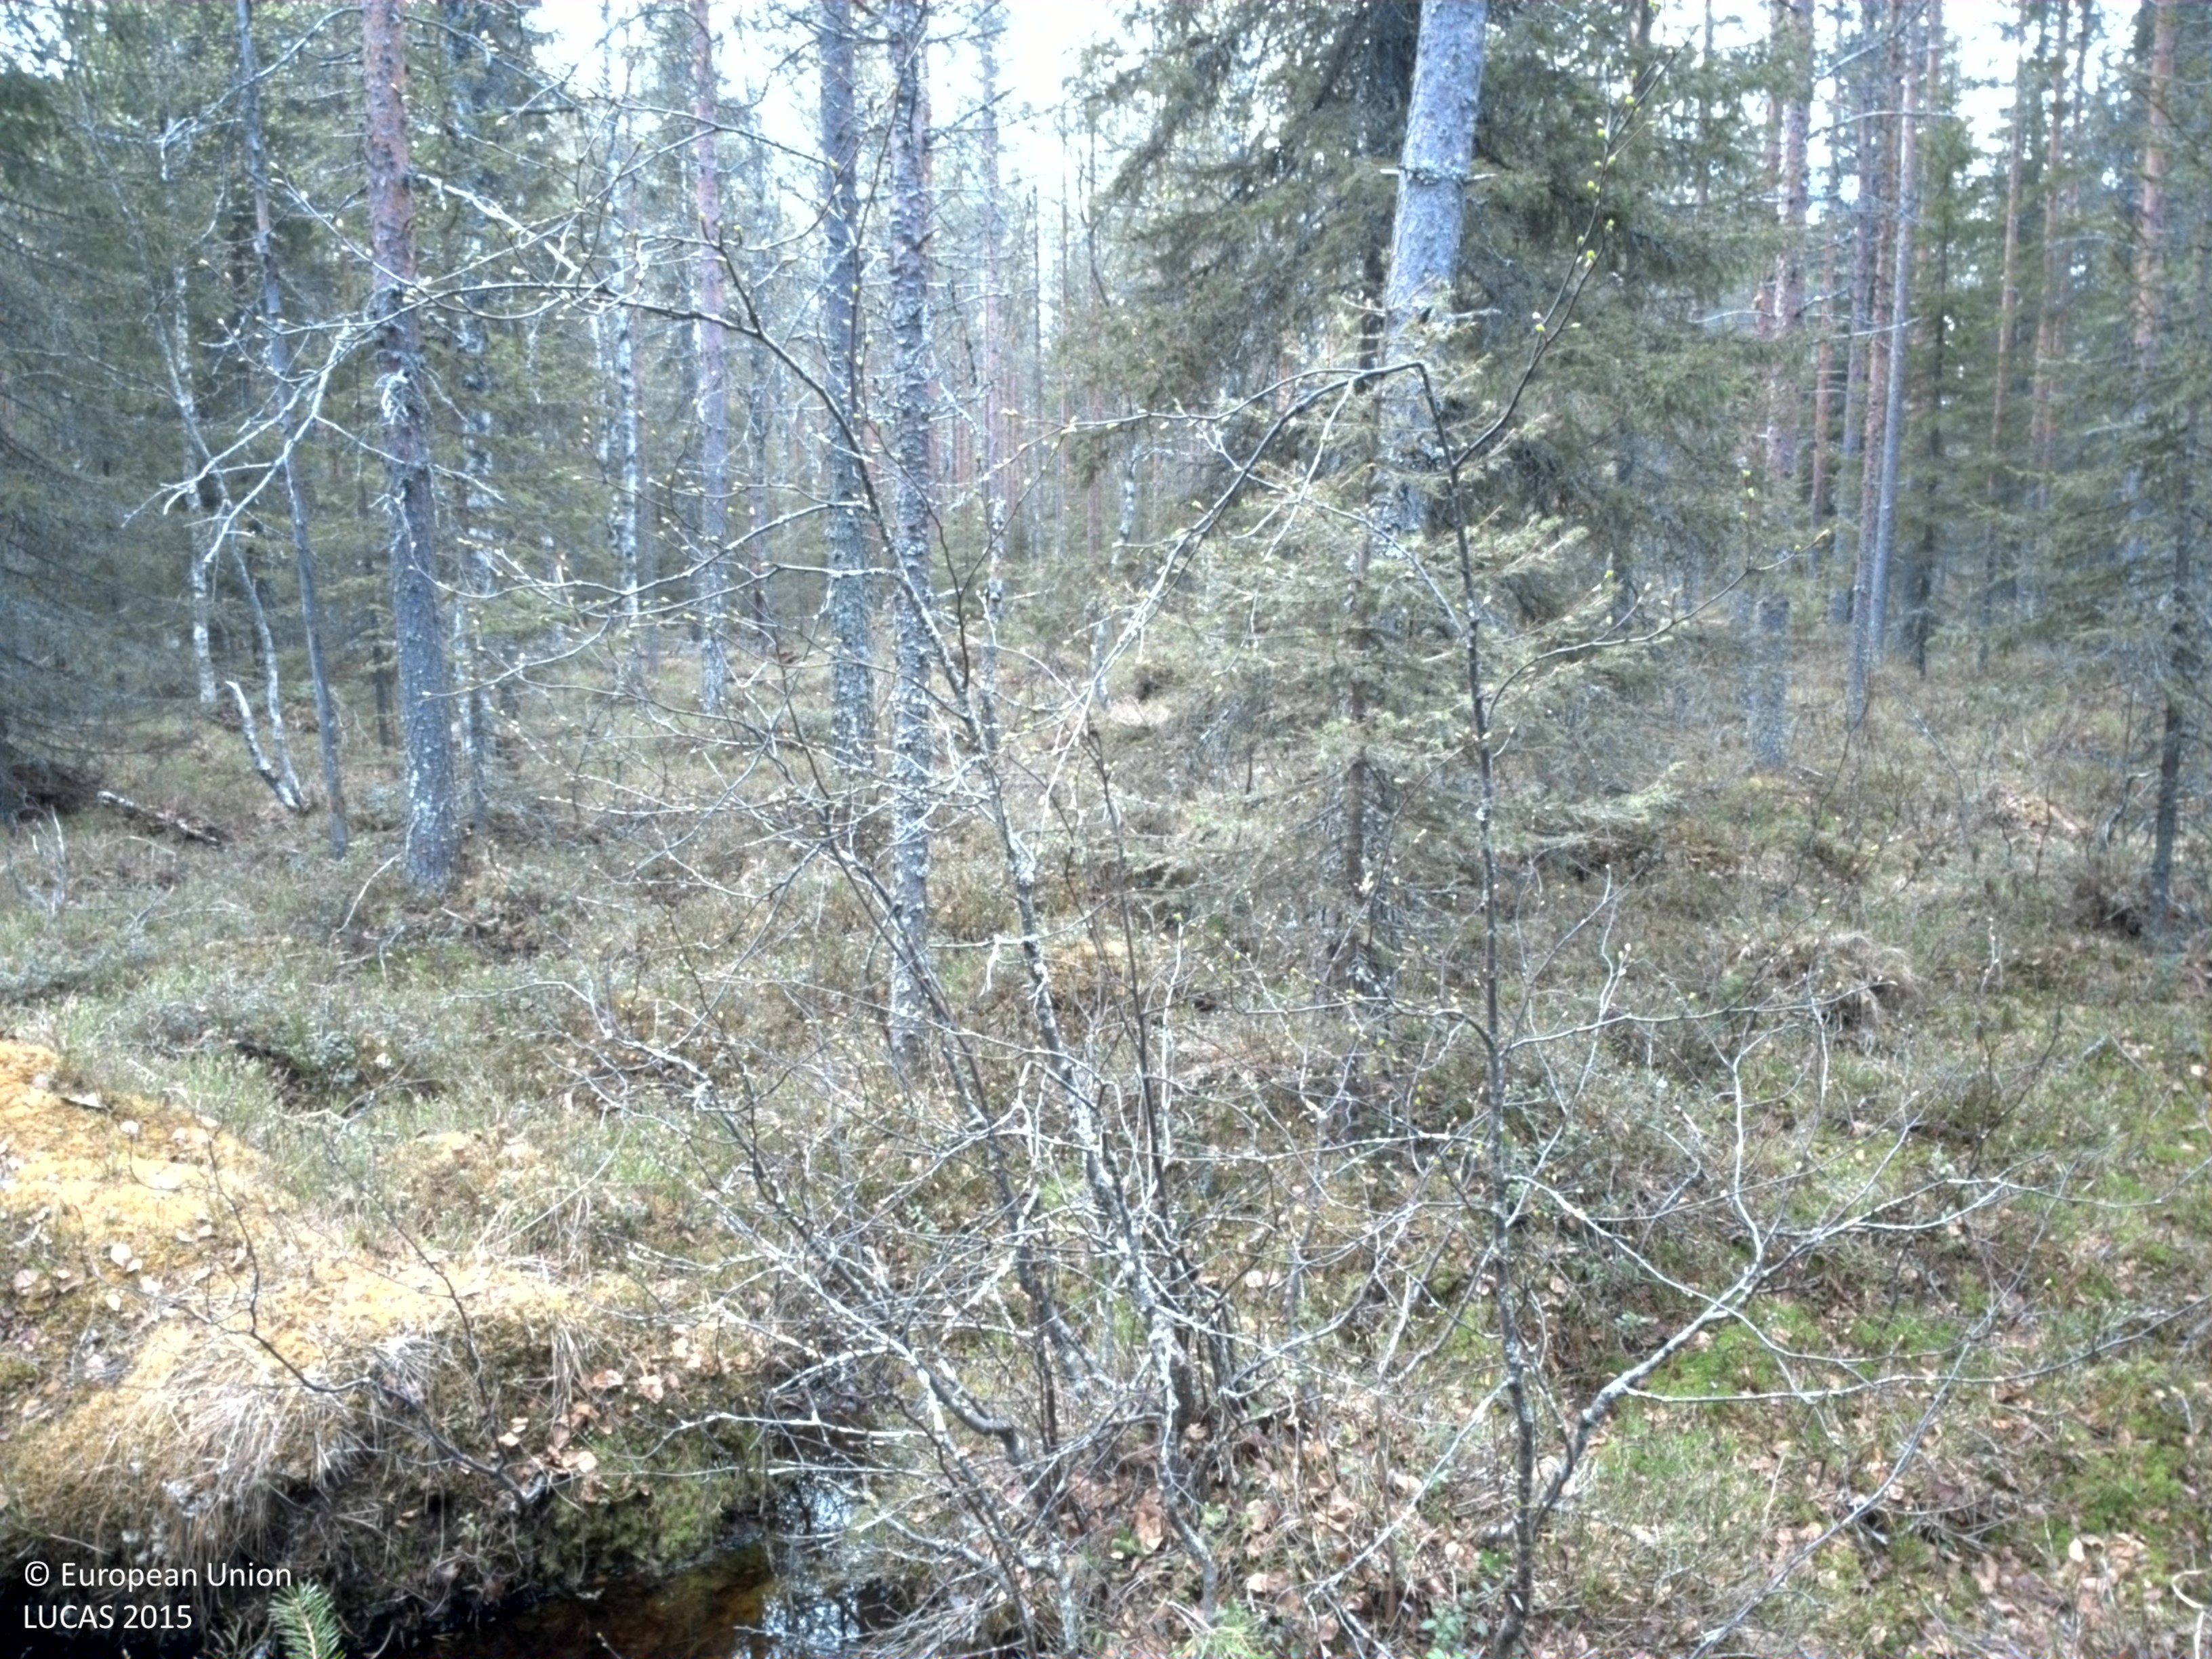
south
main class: Woodland
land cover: Pine dominated mixed woodland
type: boreal forest
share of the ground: > 75 %
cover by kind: coniferous forest trees 60 %, broadleaved forest trees 20 %, shrubs 20 %
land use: Forestry
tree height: > 5 m
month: May
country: SE
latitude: 66.0987
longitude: 23.2800
